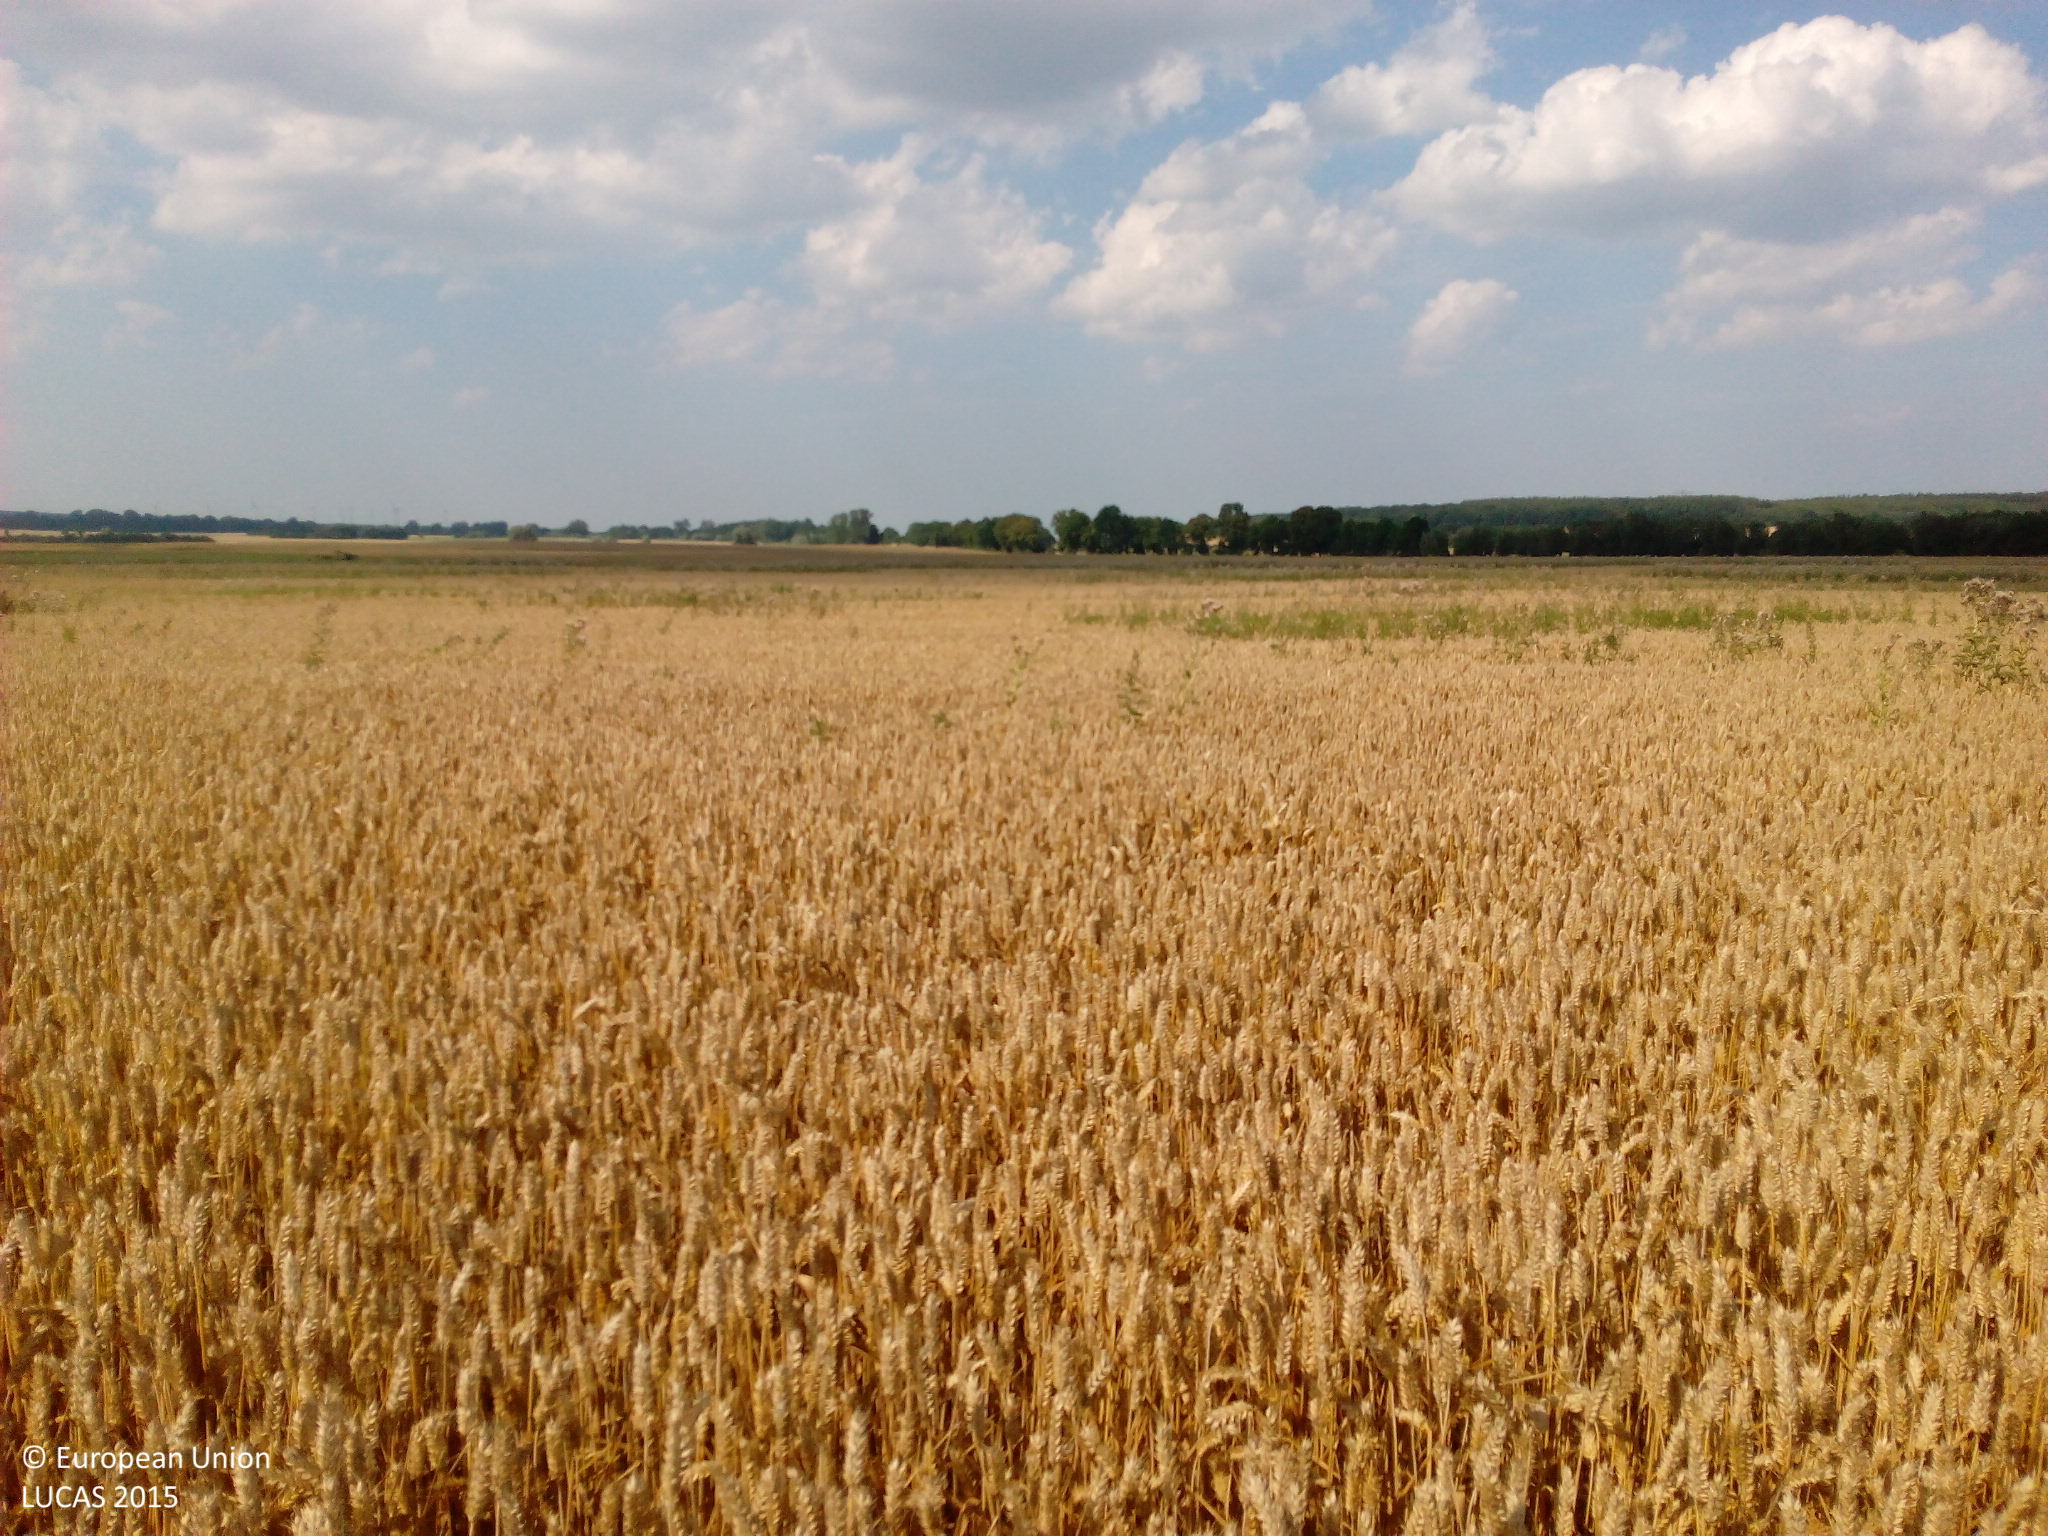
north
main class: Cropland
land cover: Common wheat
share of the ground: > 75 %
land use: Agriculture (excluding fallow land and kitchen gardens)
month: August
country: DE
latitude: 53.5821
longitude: 13.6099
